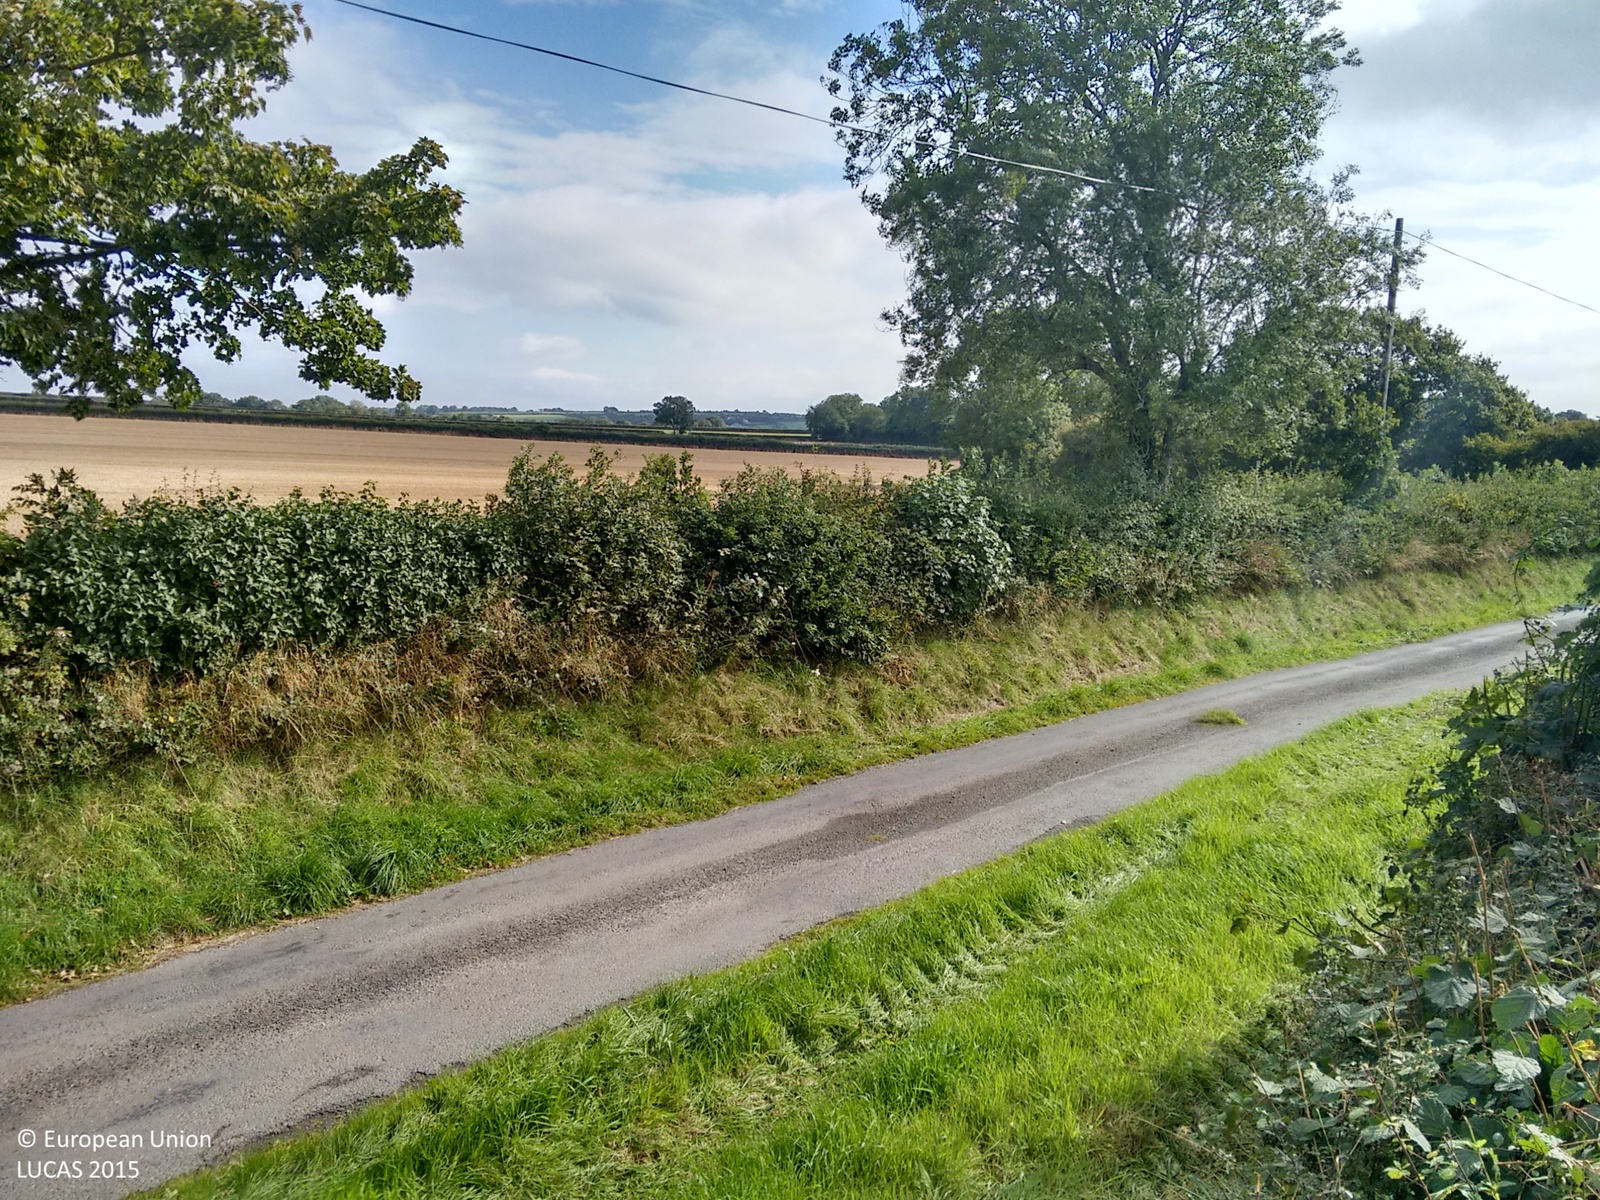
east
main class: Grassland
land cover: Grassland without tree/shrub cover
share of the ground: > 75 %
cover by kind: herbaceous plants 100 %
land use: Agriculture (excluding fallow land and kitchen gardens)
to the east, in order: Grassland without tree/shrub cover
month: September
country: GB
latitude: 52.0582
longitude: -4.5604
